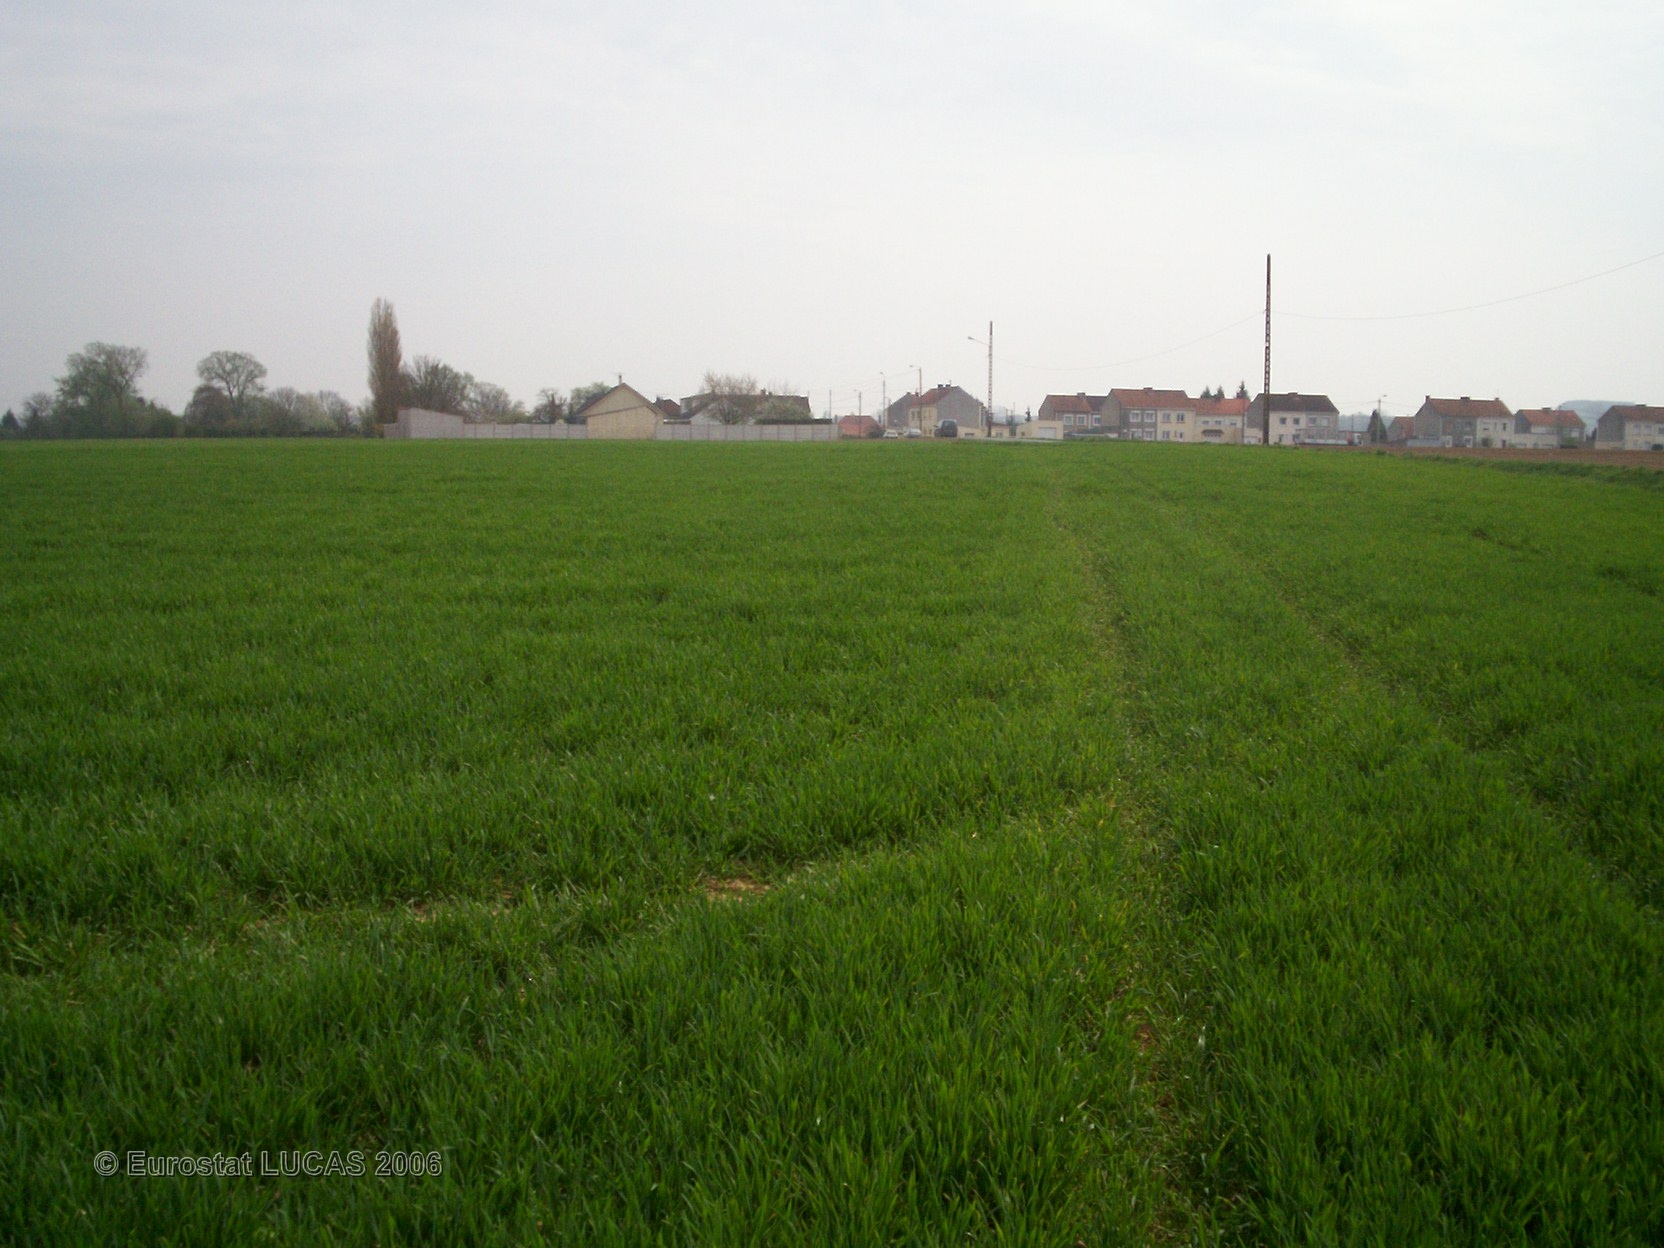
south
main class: Cropland
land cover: Common wheat
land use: Agriculture (excluding fallow land and kitchen gardens)
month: April
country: FR
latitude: 50.5328
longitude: 2.4959
